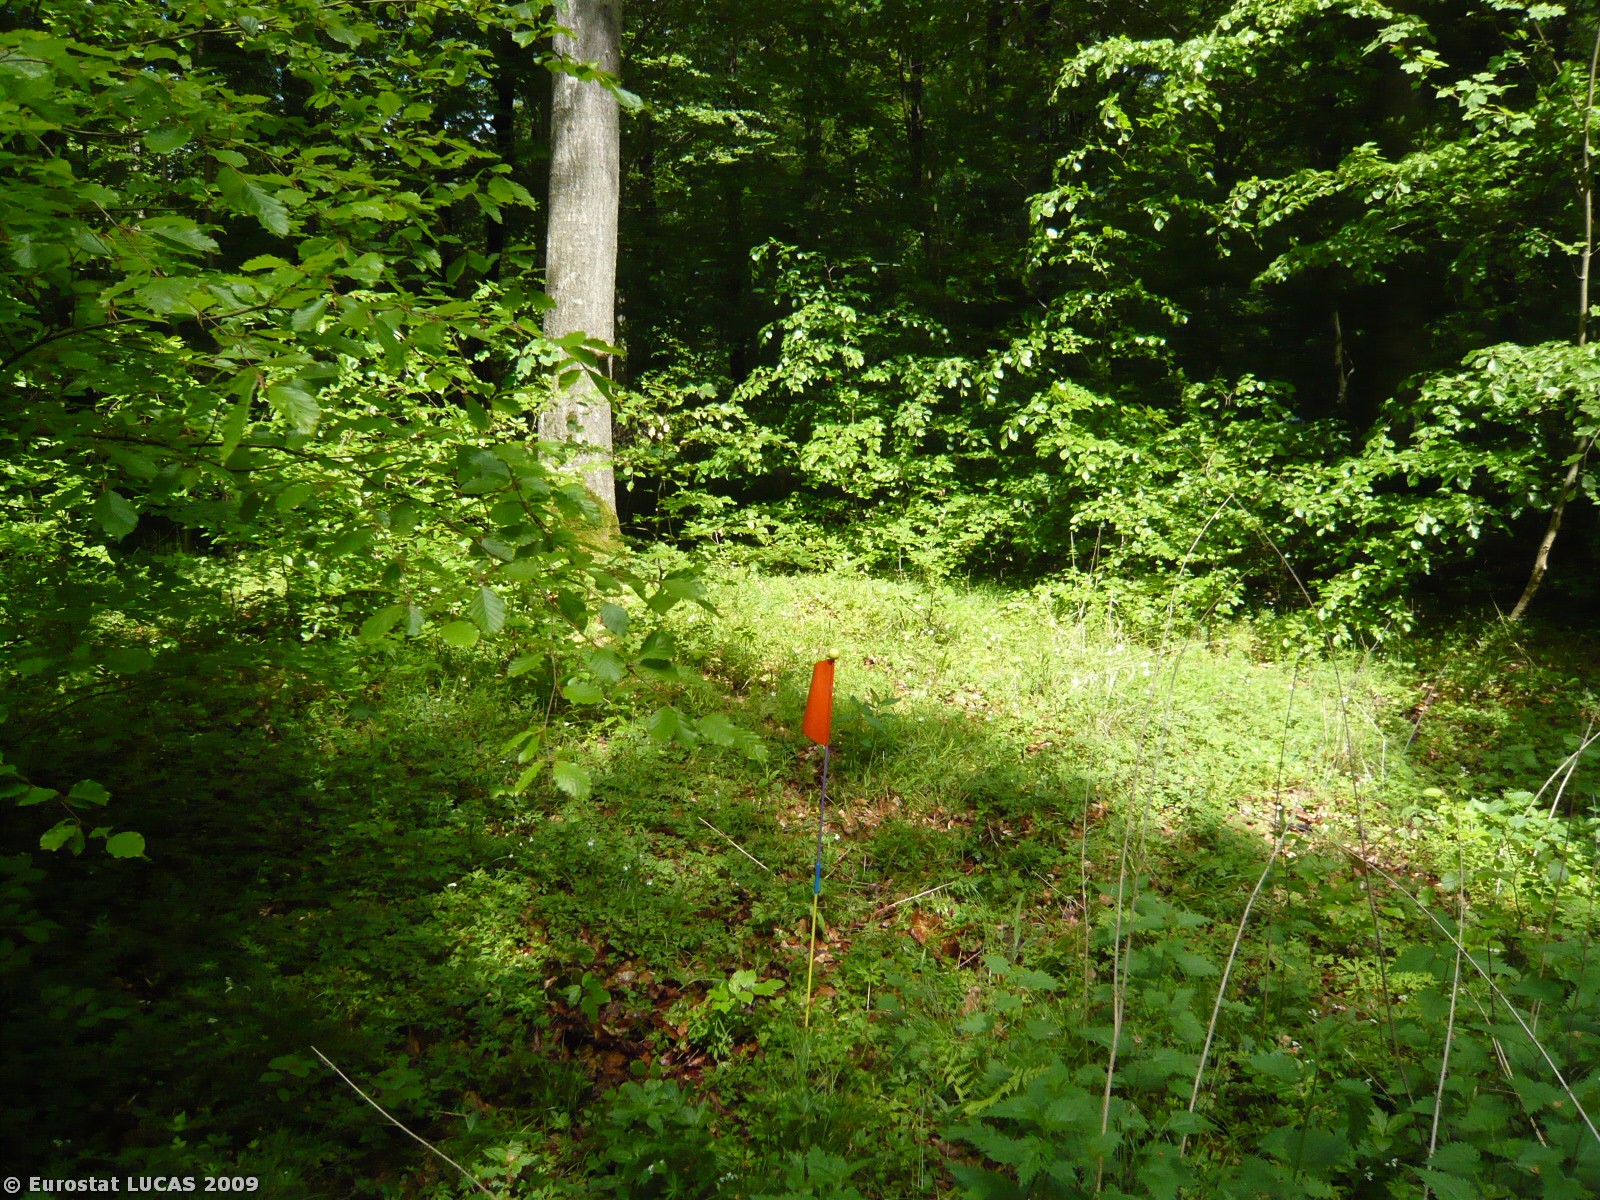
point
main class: Woodland
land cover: Broadleaved woodland
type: mesophytic deciduous forest
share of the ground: > 75 %
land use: Forestry
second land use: Amenities, museums, leisure
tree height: > 5 m
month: May
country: DK
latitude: 55.4228
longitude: 11.5944
